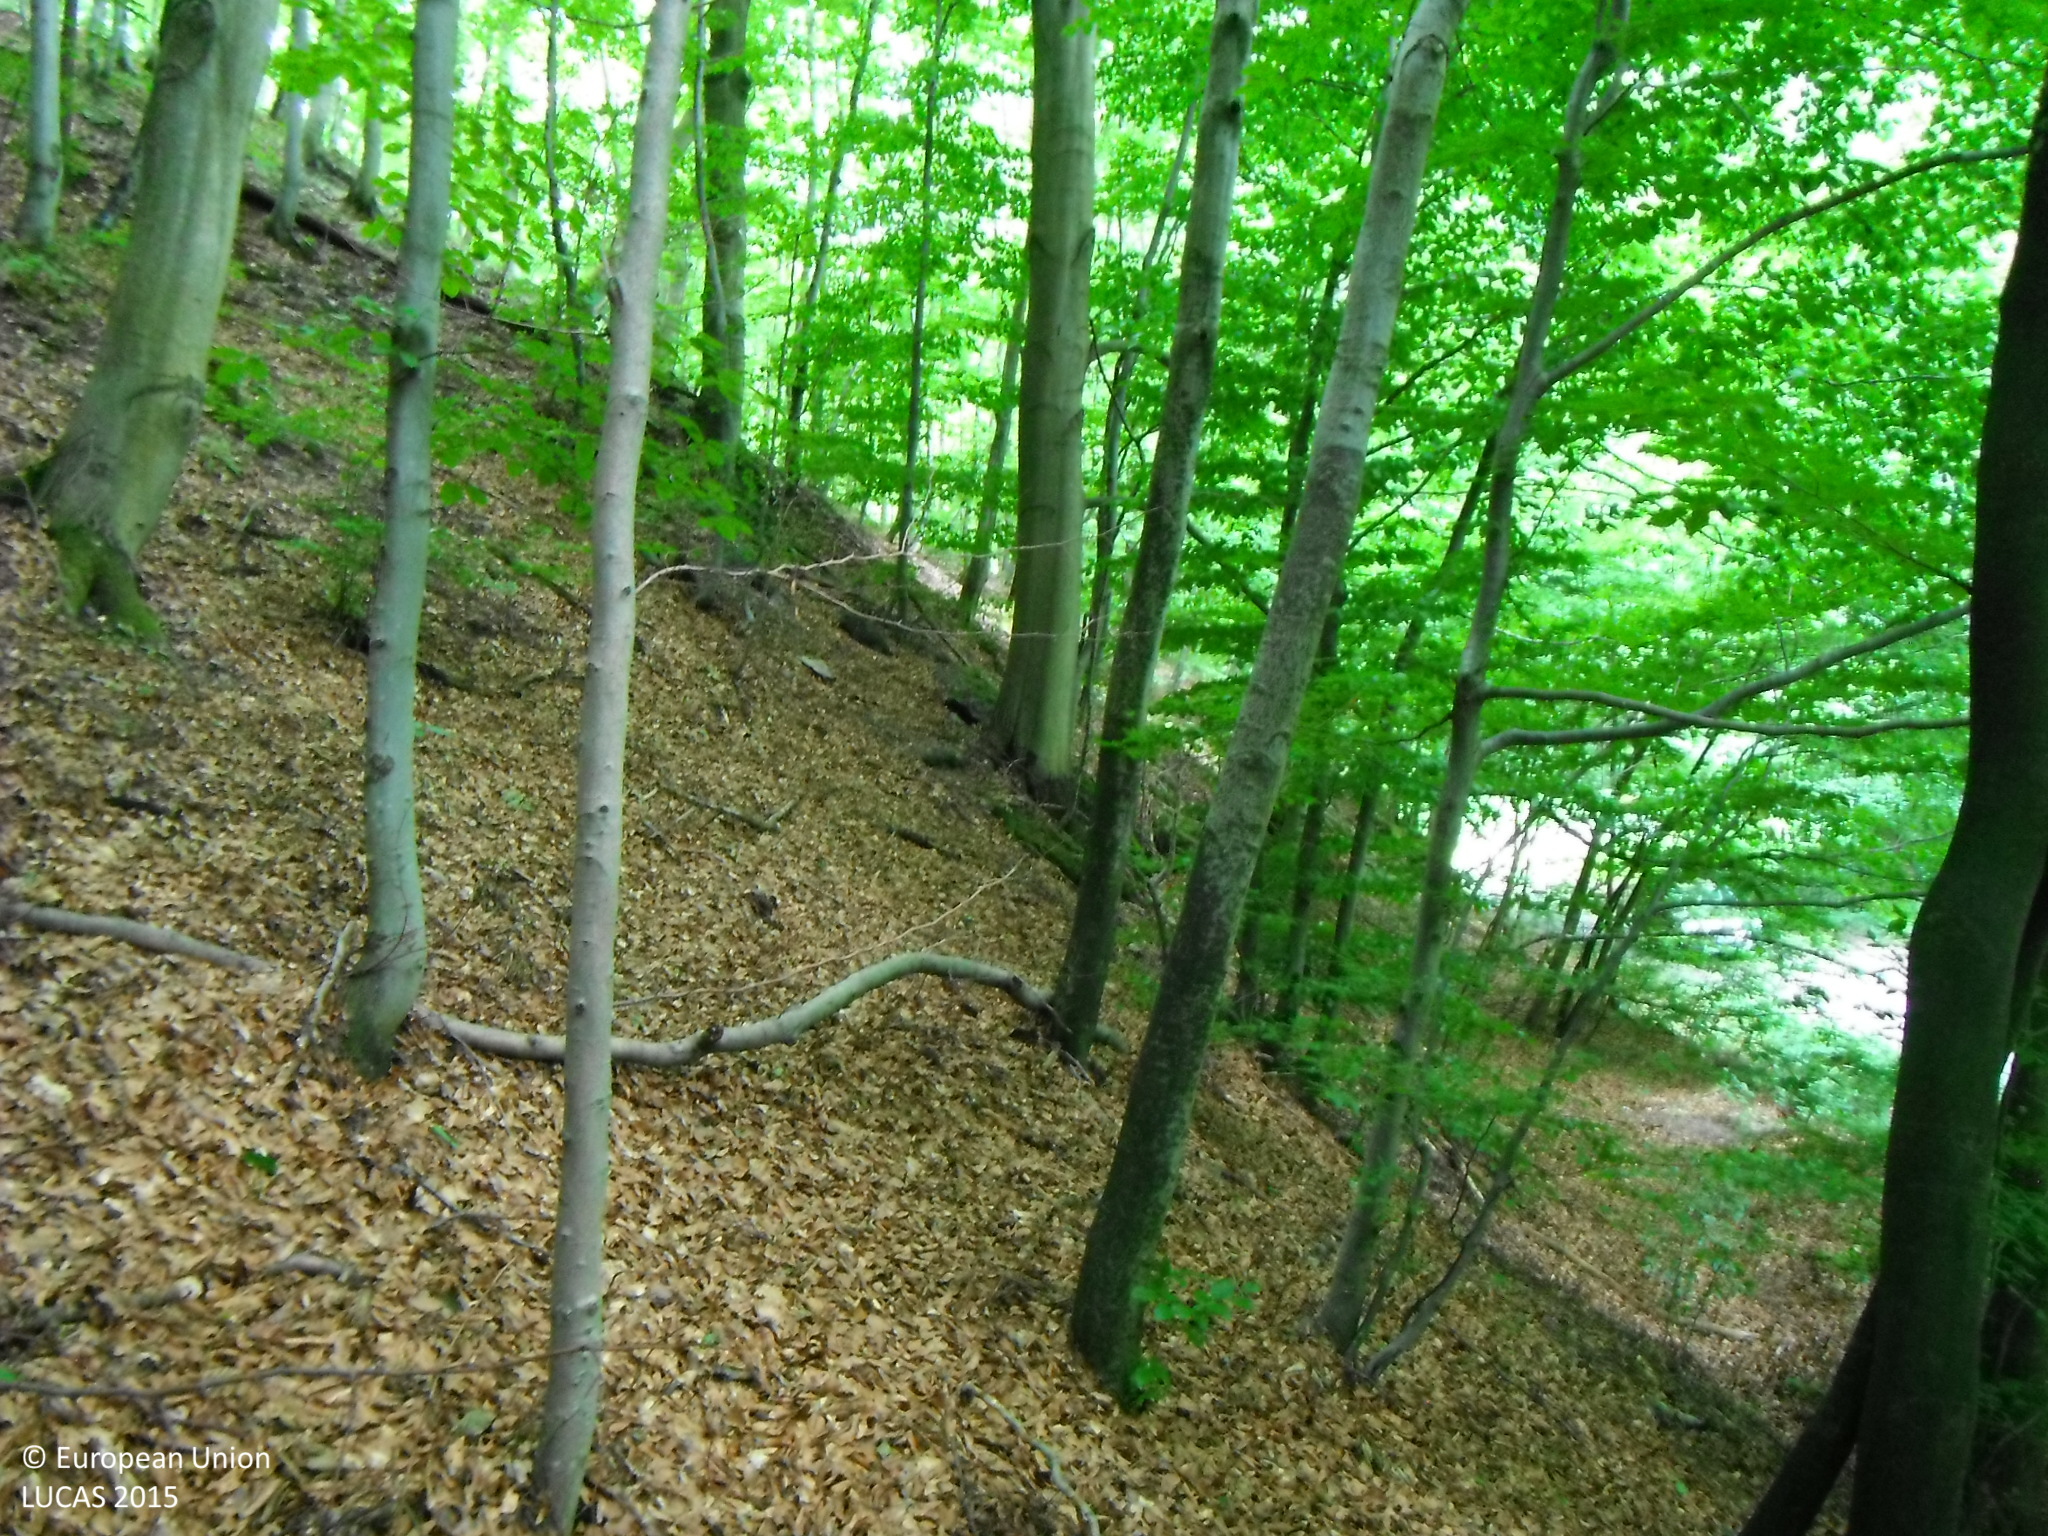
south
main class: Woodland
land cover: Spruce dominated mixed woodland
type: hemiboreal forest and nemoral coniferous forest and mixed broadleaved-coniferous forest
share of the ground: > 75 %
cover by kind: broadleaved forest trees 70 %, coniferous forest trees 30 %
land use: Forestry
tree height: > 5 m
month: July
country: SK
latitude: 48.7534
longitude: 21.0732
